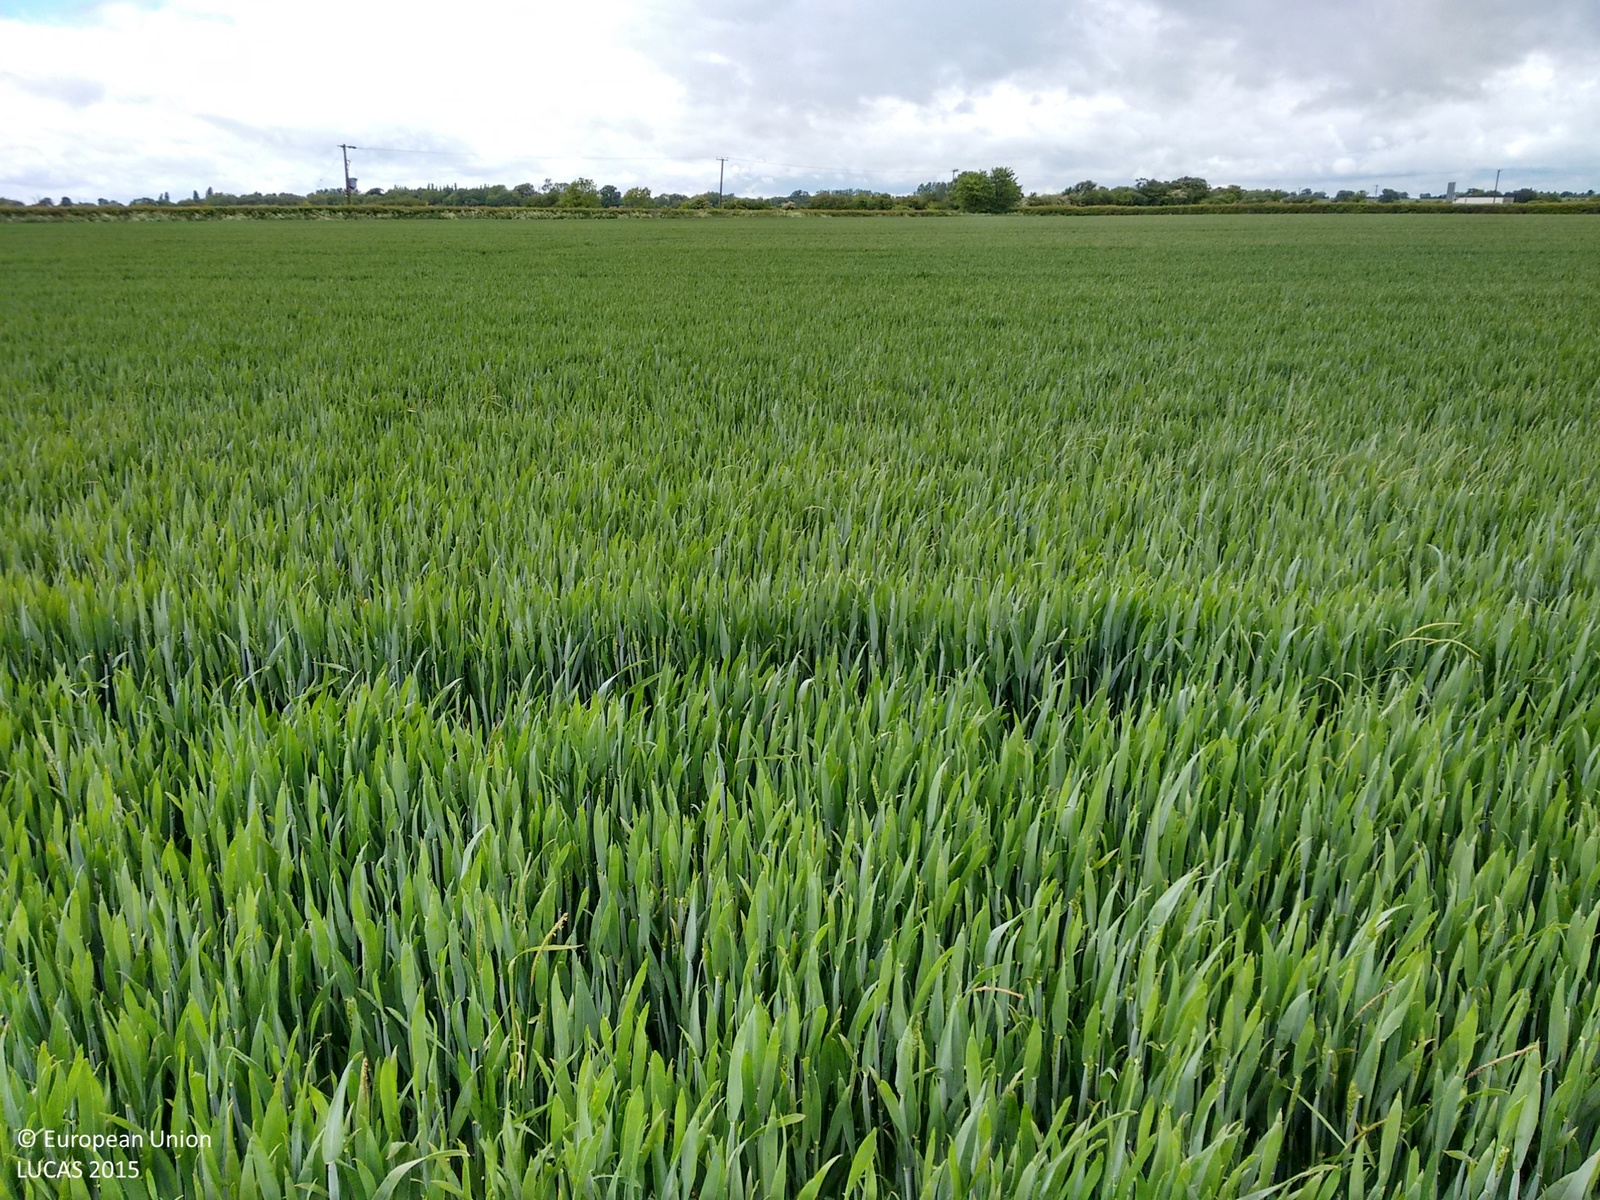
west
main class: Cropland
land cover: Common wheat
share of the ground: > 75 %
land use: Agriculture (excluding fallow land and kitchen gardens)
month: May
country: GB
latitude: 52.1576
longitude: -0.3712
